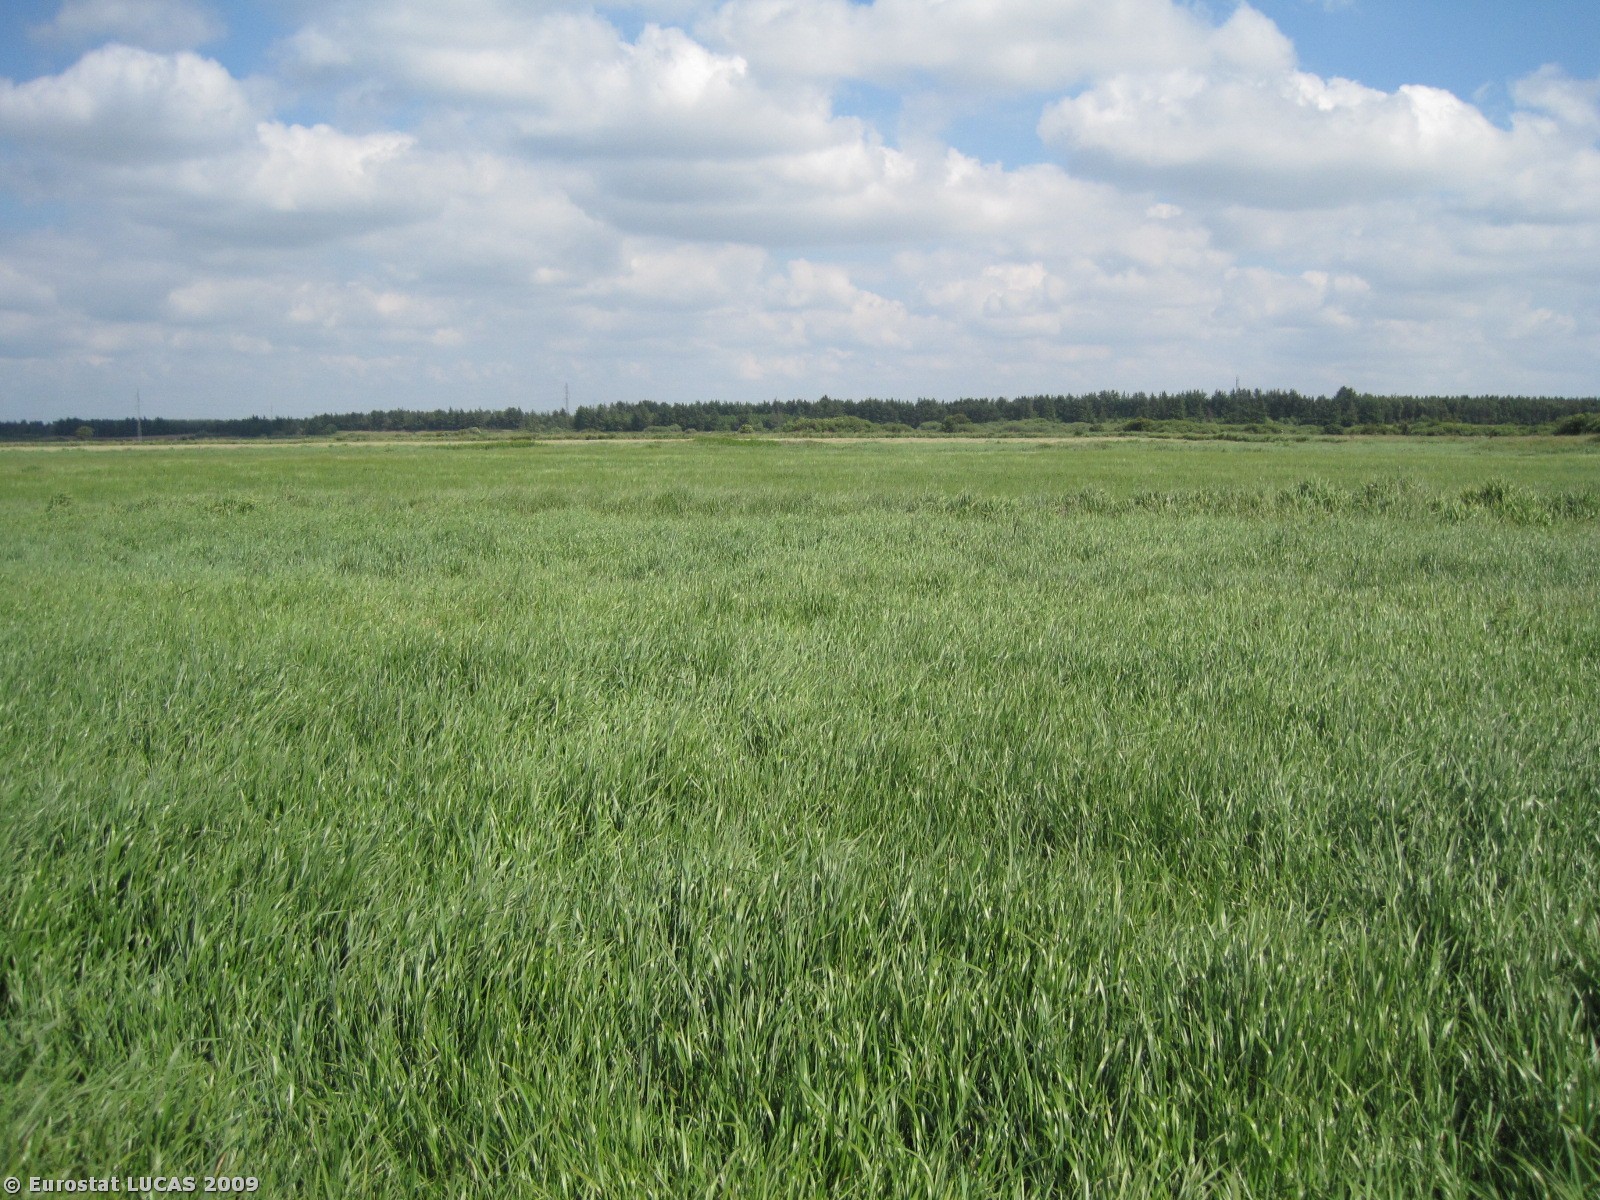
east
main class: Grassland
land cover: Grassland without tree/shrub cover
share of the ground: > 75 %
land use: Agriculture (excluding fallow land and kitchen gardens)
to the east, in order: Grassland without tree/shrub cover; Rye; Grassland without tree/shrub cover
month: June
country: DK
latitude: 56.5252
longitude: 8.9772
